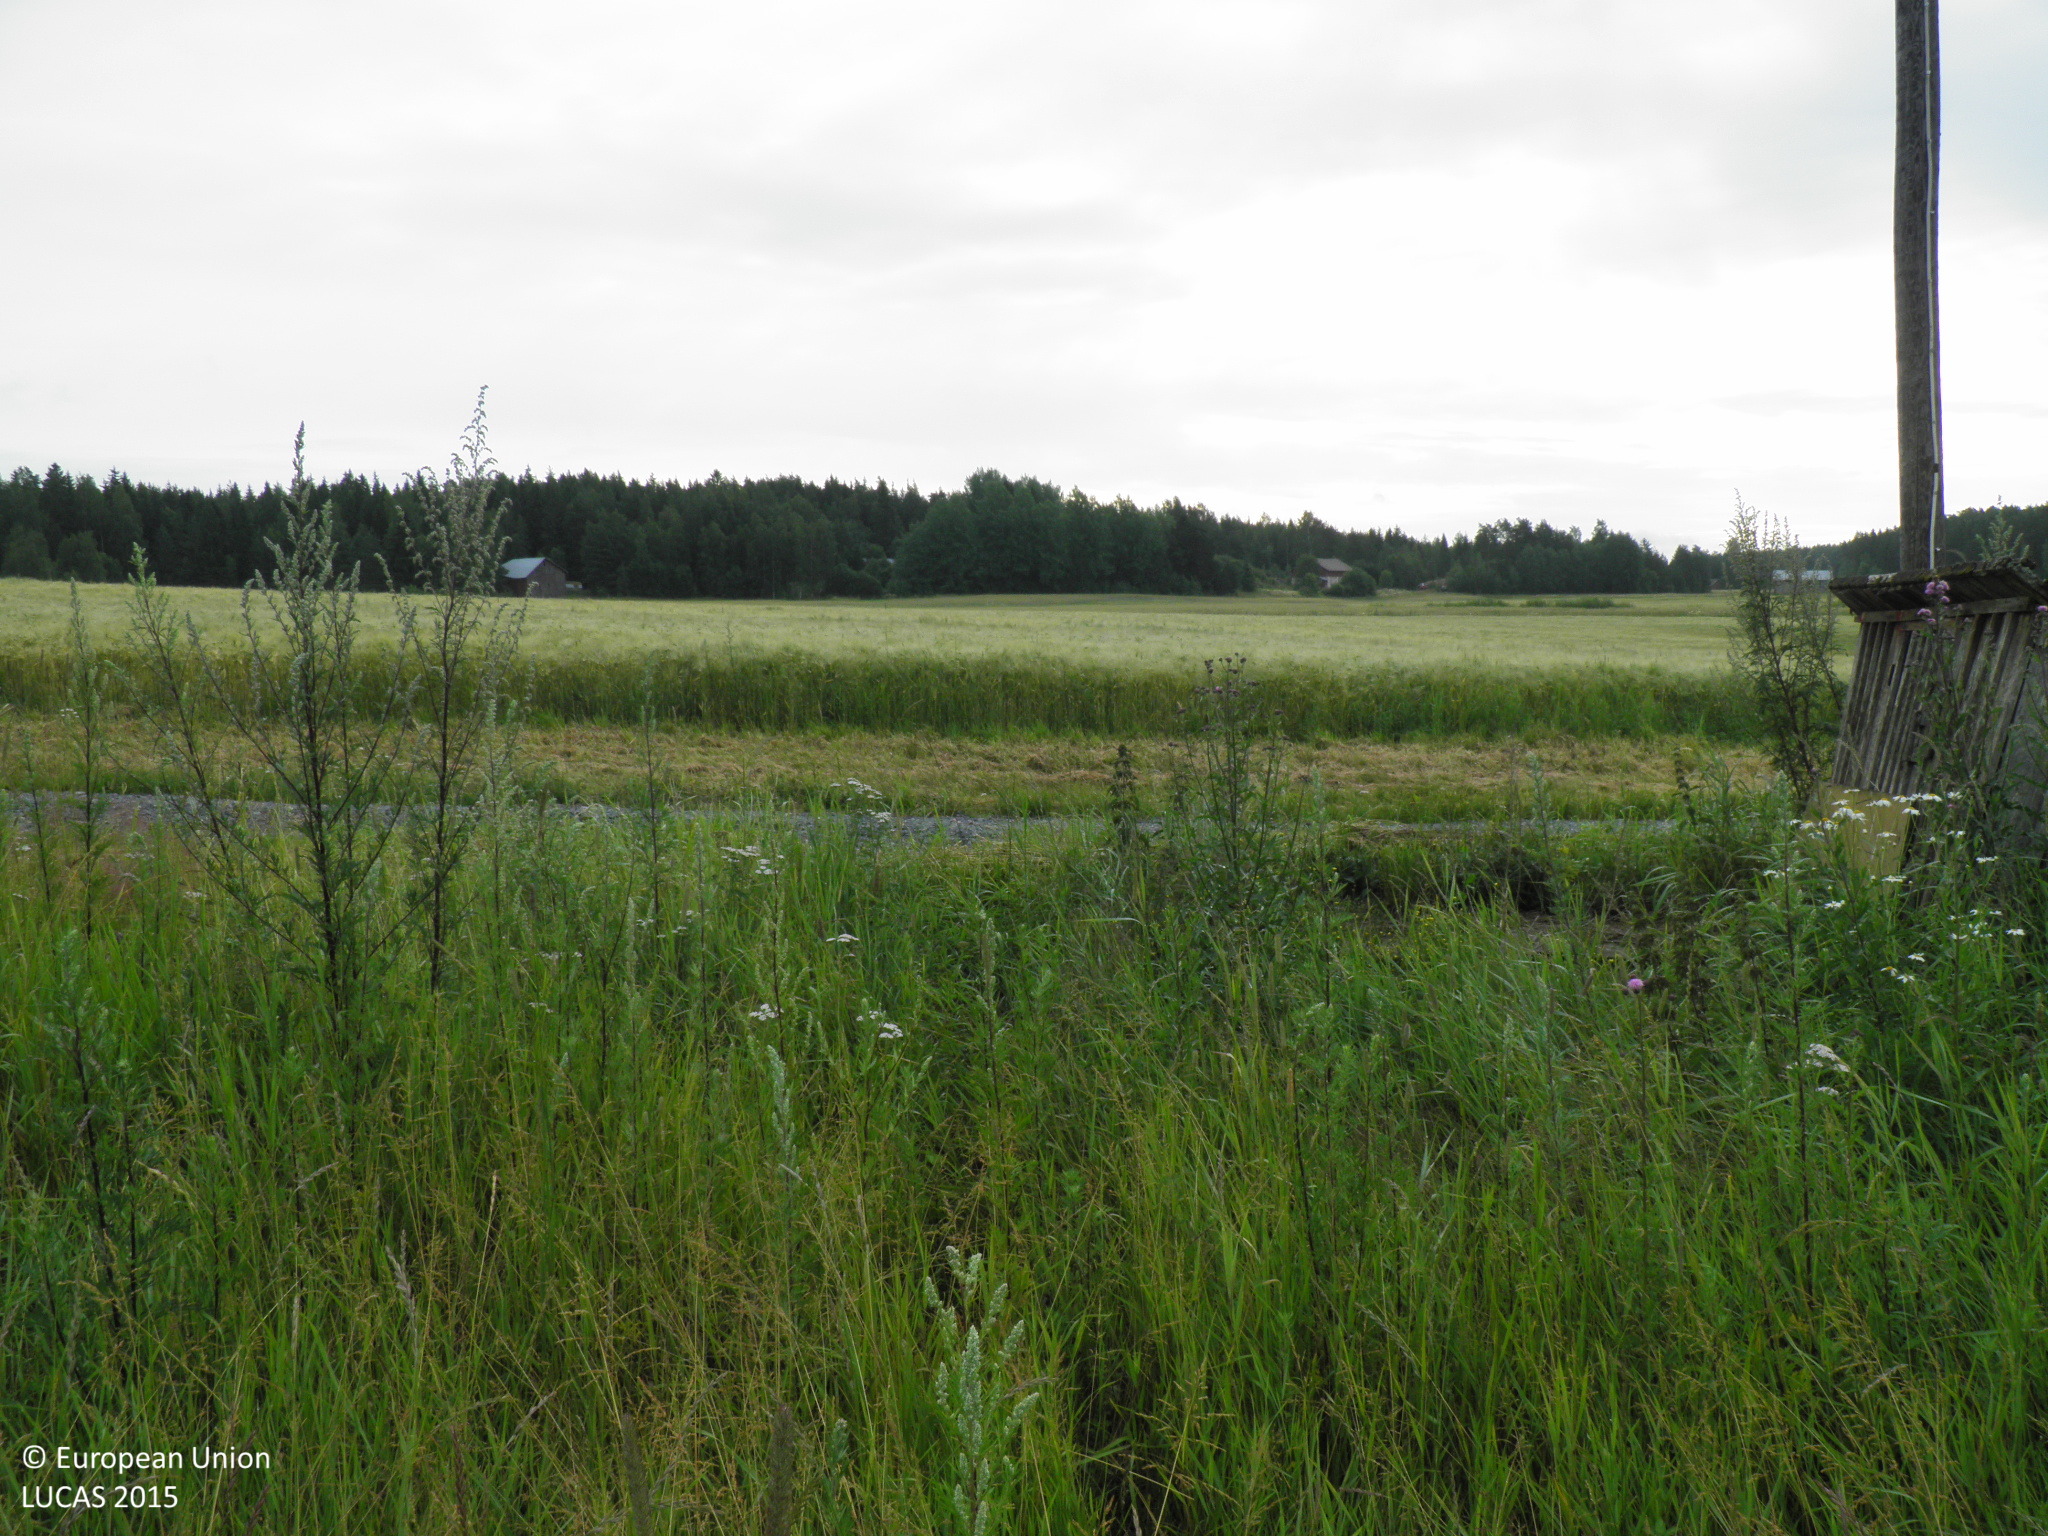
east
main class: Cropland
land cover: Barley
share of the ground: > 75 %
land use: Agriculture (excluding fallow land and kitchen gardens)
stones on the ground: < 10 %
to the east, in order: Barley; Electric lines; Grass margins; Tracks; Grass margins; Barley; Grass margins; Ditches and canals; Electric lines; Grass margins; Common wheat; Grass margins; Ditches and canals; Grass margins; Common wheat
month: July
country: FI
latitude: 60.1483
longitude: 22.7377
